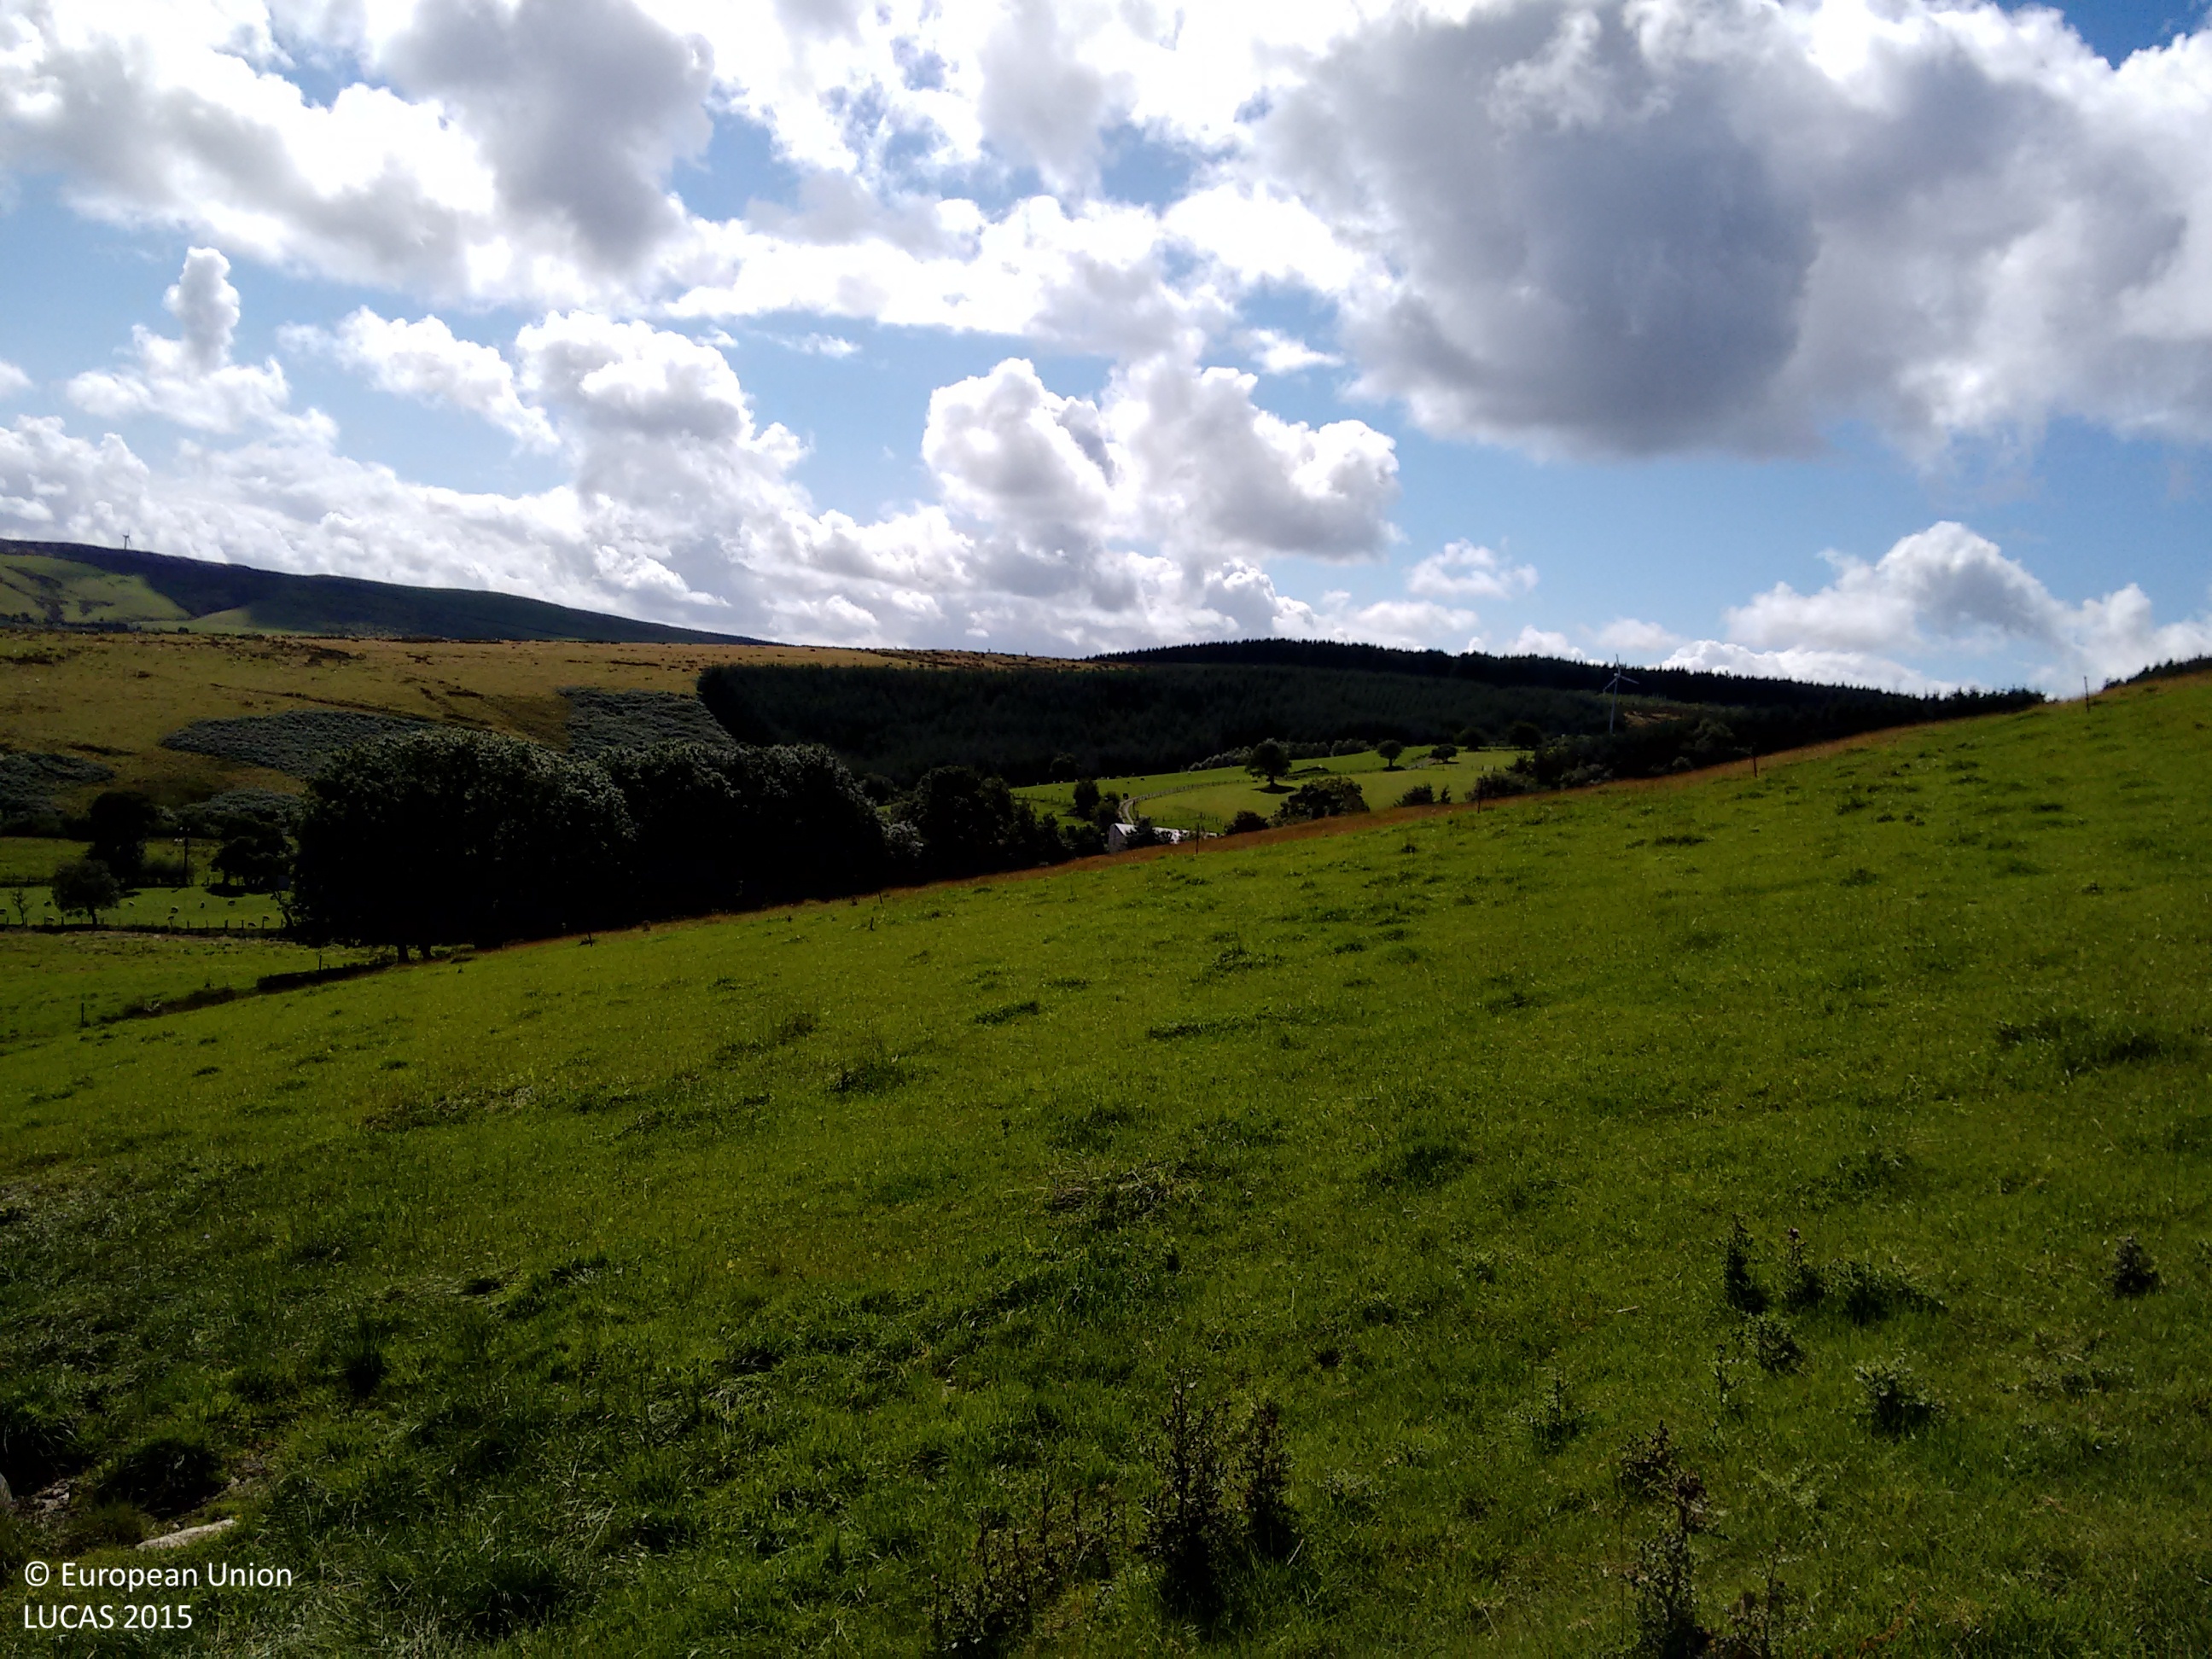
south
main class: Grassland
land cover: Grassland without tree/shrub cover
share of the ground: > 75 %
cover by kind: herbaceous plants 100 %
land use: Agriculture (excluding fallow land and kitchen gardens)
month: August
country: GB
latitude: 53.1315
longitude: -3.5209
